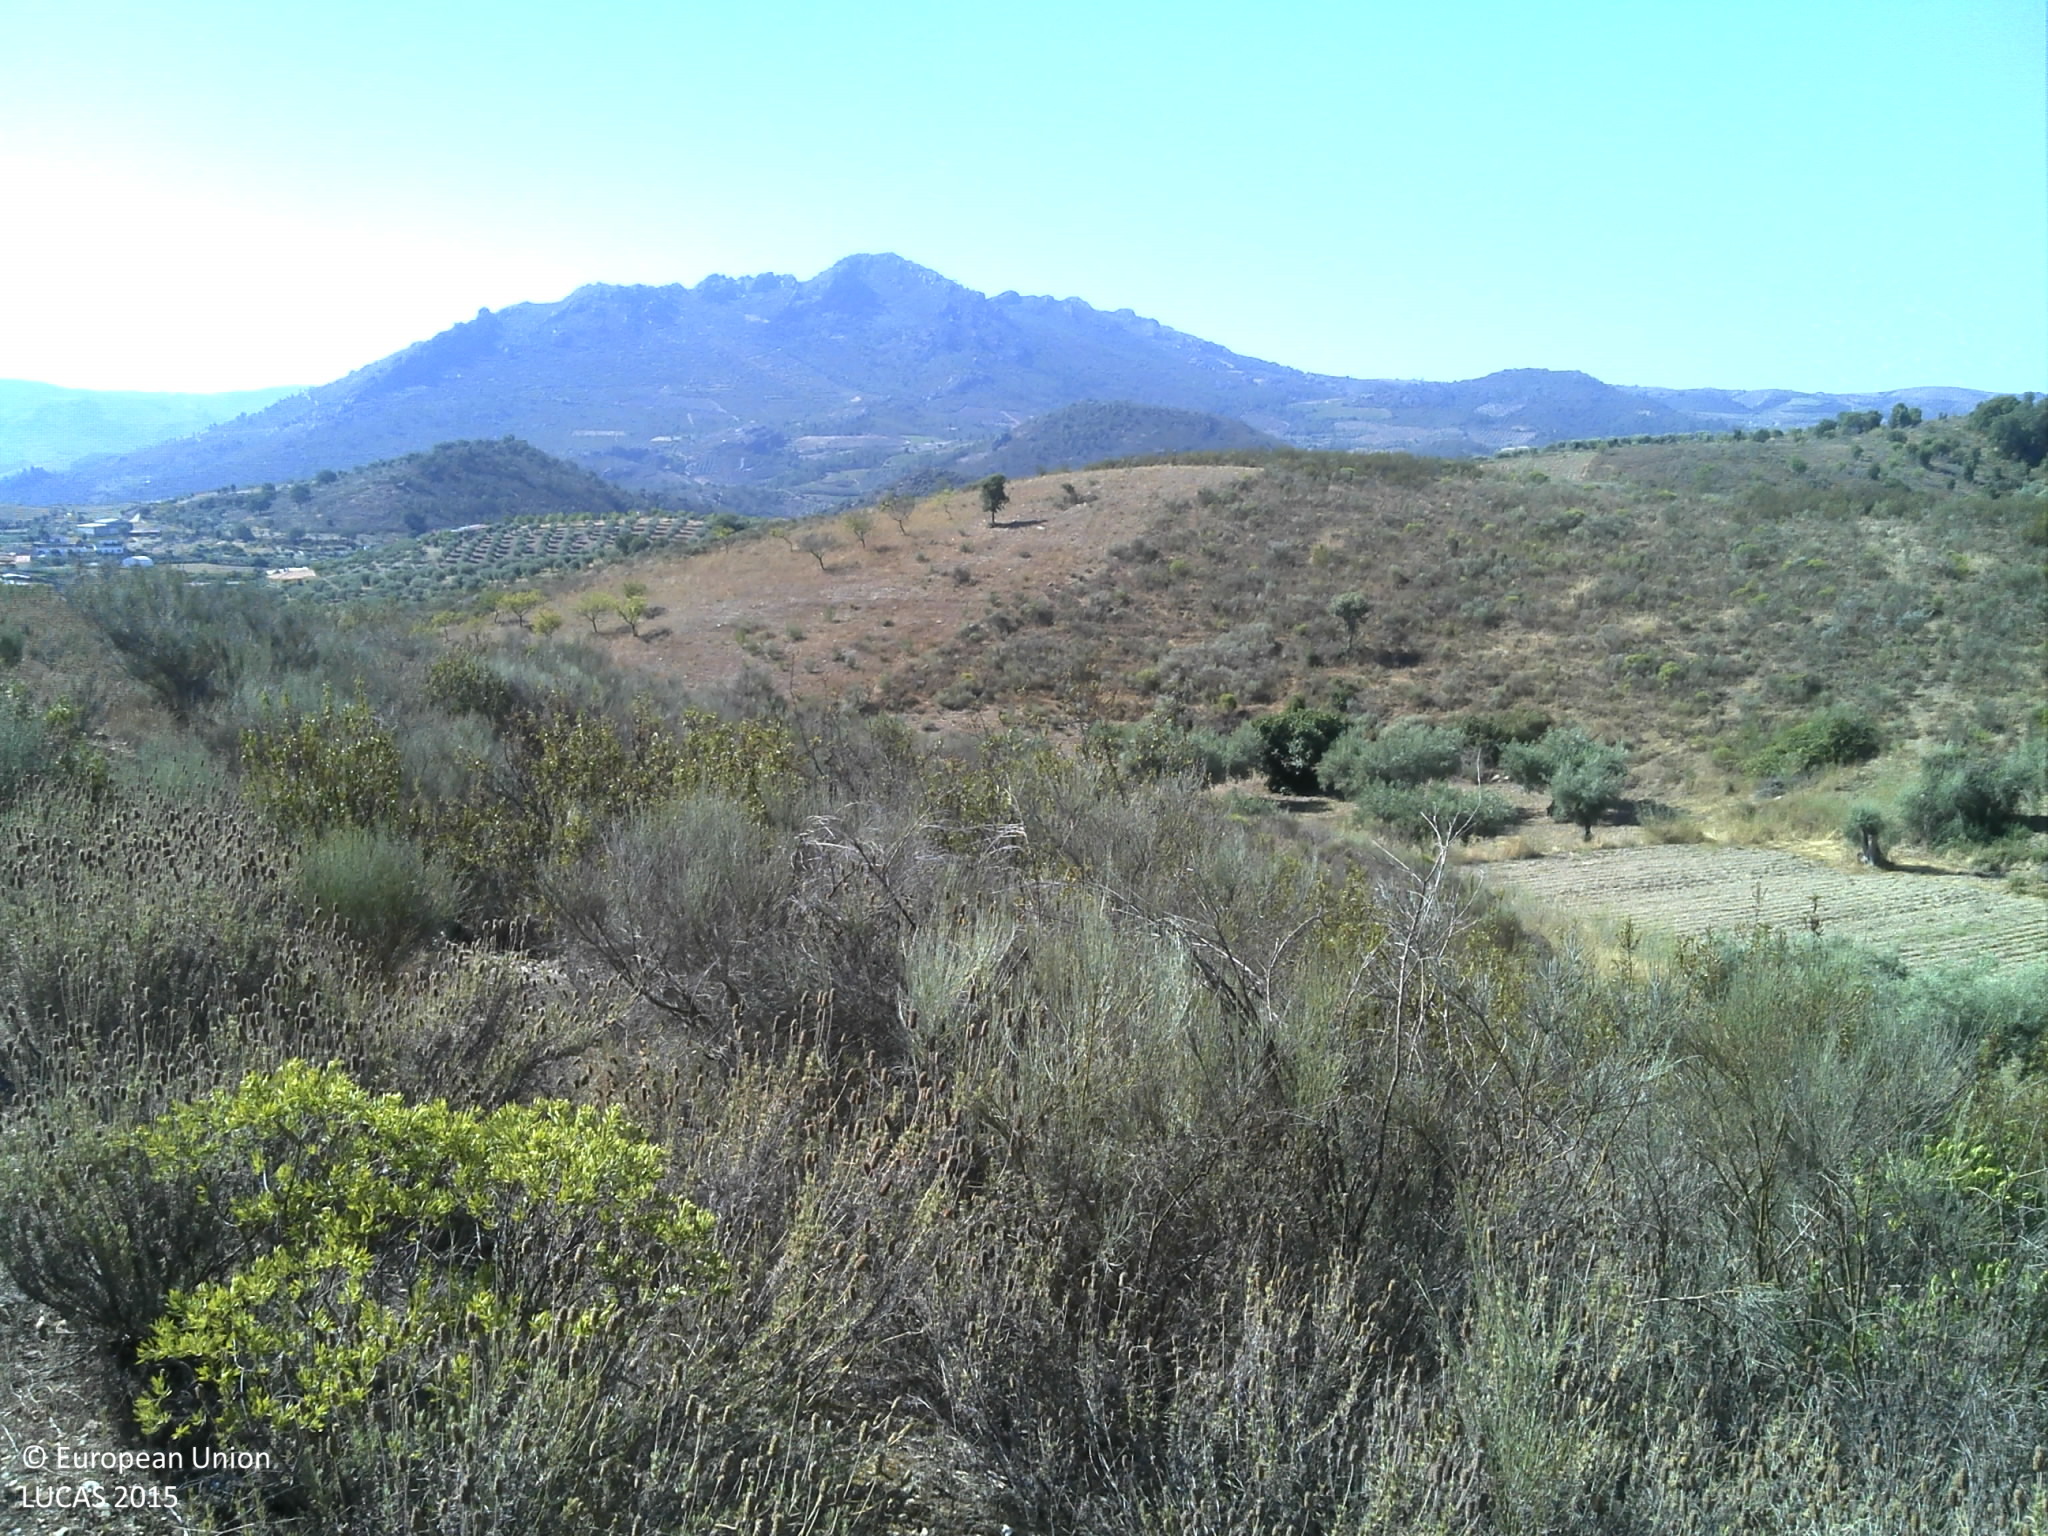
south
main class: Shrubland
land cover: Shrubland without tree cover
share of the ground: 25 - 50 %
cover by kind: shrubs 45 %, unconsolidated bare surface 35 %, herbaceous plants 10 %, consolidated bare surface 10 %
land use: Fallow land
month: July
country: PT
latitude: 41.4069
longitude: -7.2126
